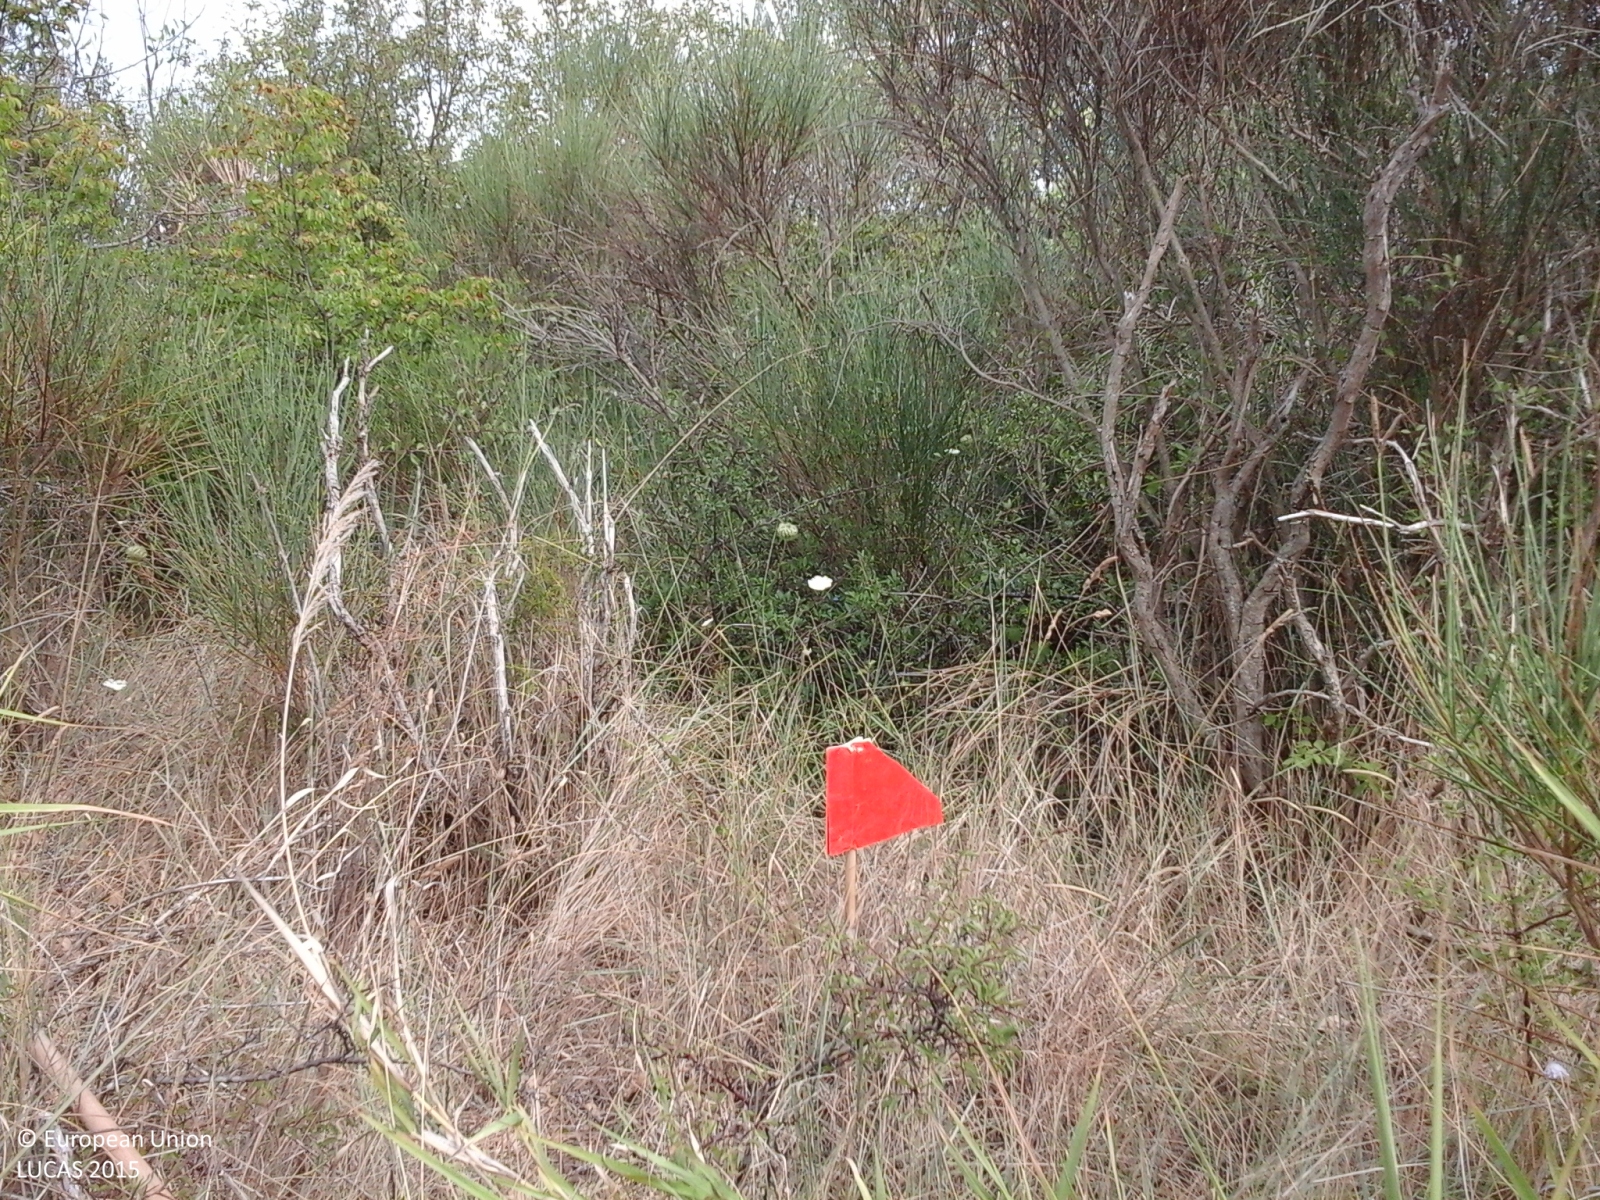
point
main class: Shrubland
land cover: Shrubland with sparse tree cover
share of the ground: > 75 %
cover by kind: shrubs 95 %, broadleaved forest trees 5 %
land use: Abandoned areas
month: July
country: IT
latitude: 41.7471
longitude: 14.7343
